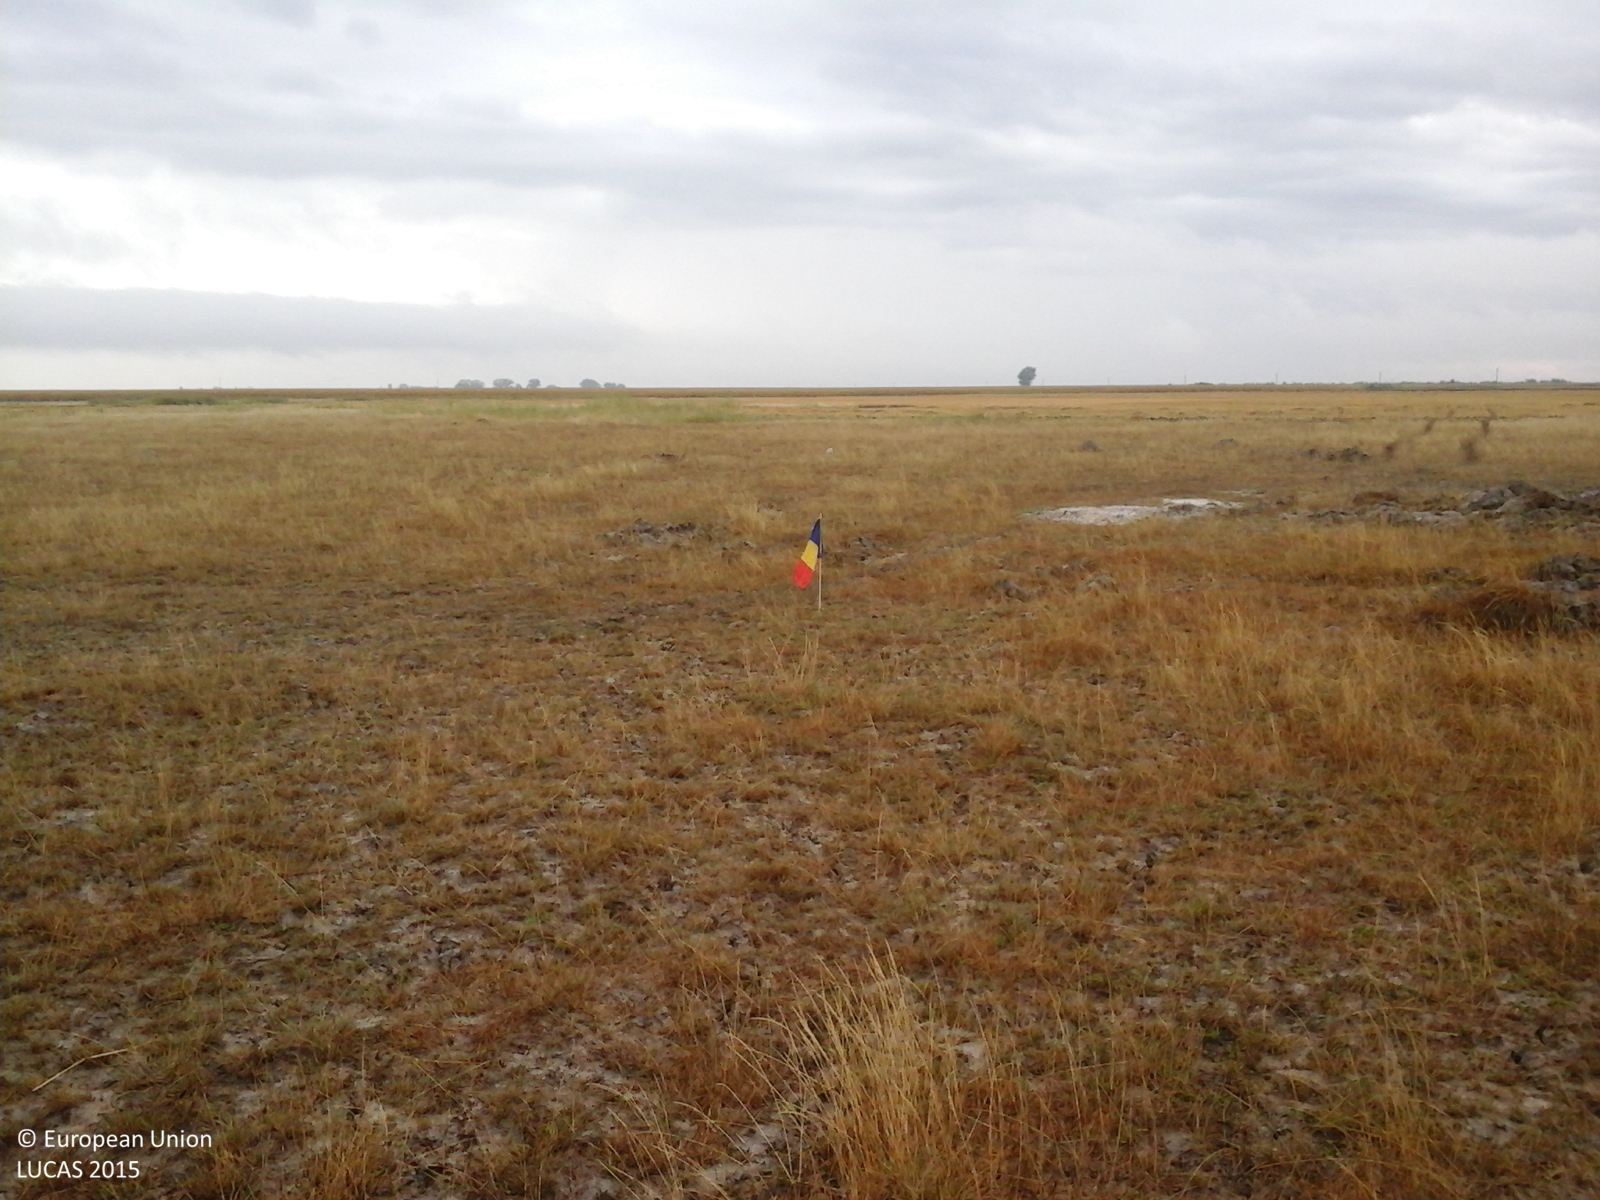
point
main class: Grassland
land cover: Grassland without tree/shrub cover
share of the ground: > 75 %
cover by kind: herbaceous plants 100 %
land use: Agriculture (excluding fallow land and kitchen gardens)
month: August
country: RO
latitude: 45.5811
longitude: 21.0105
